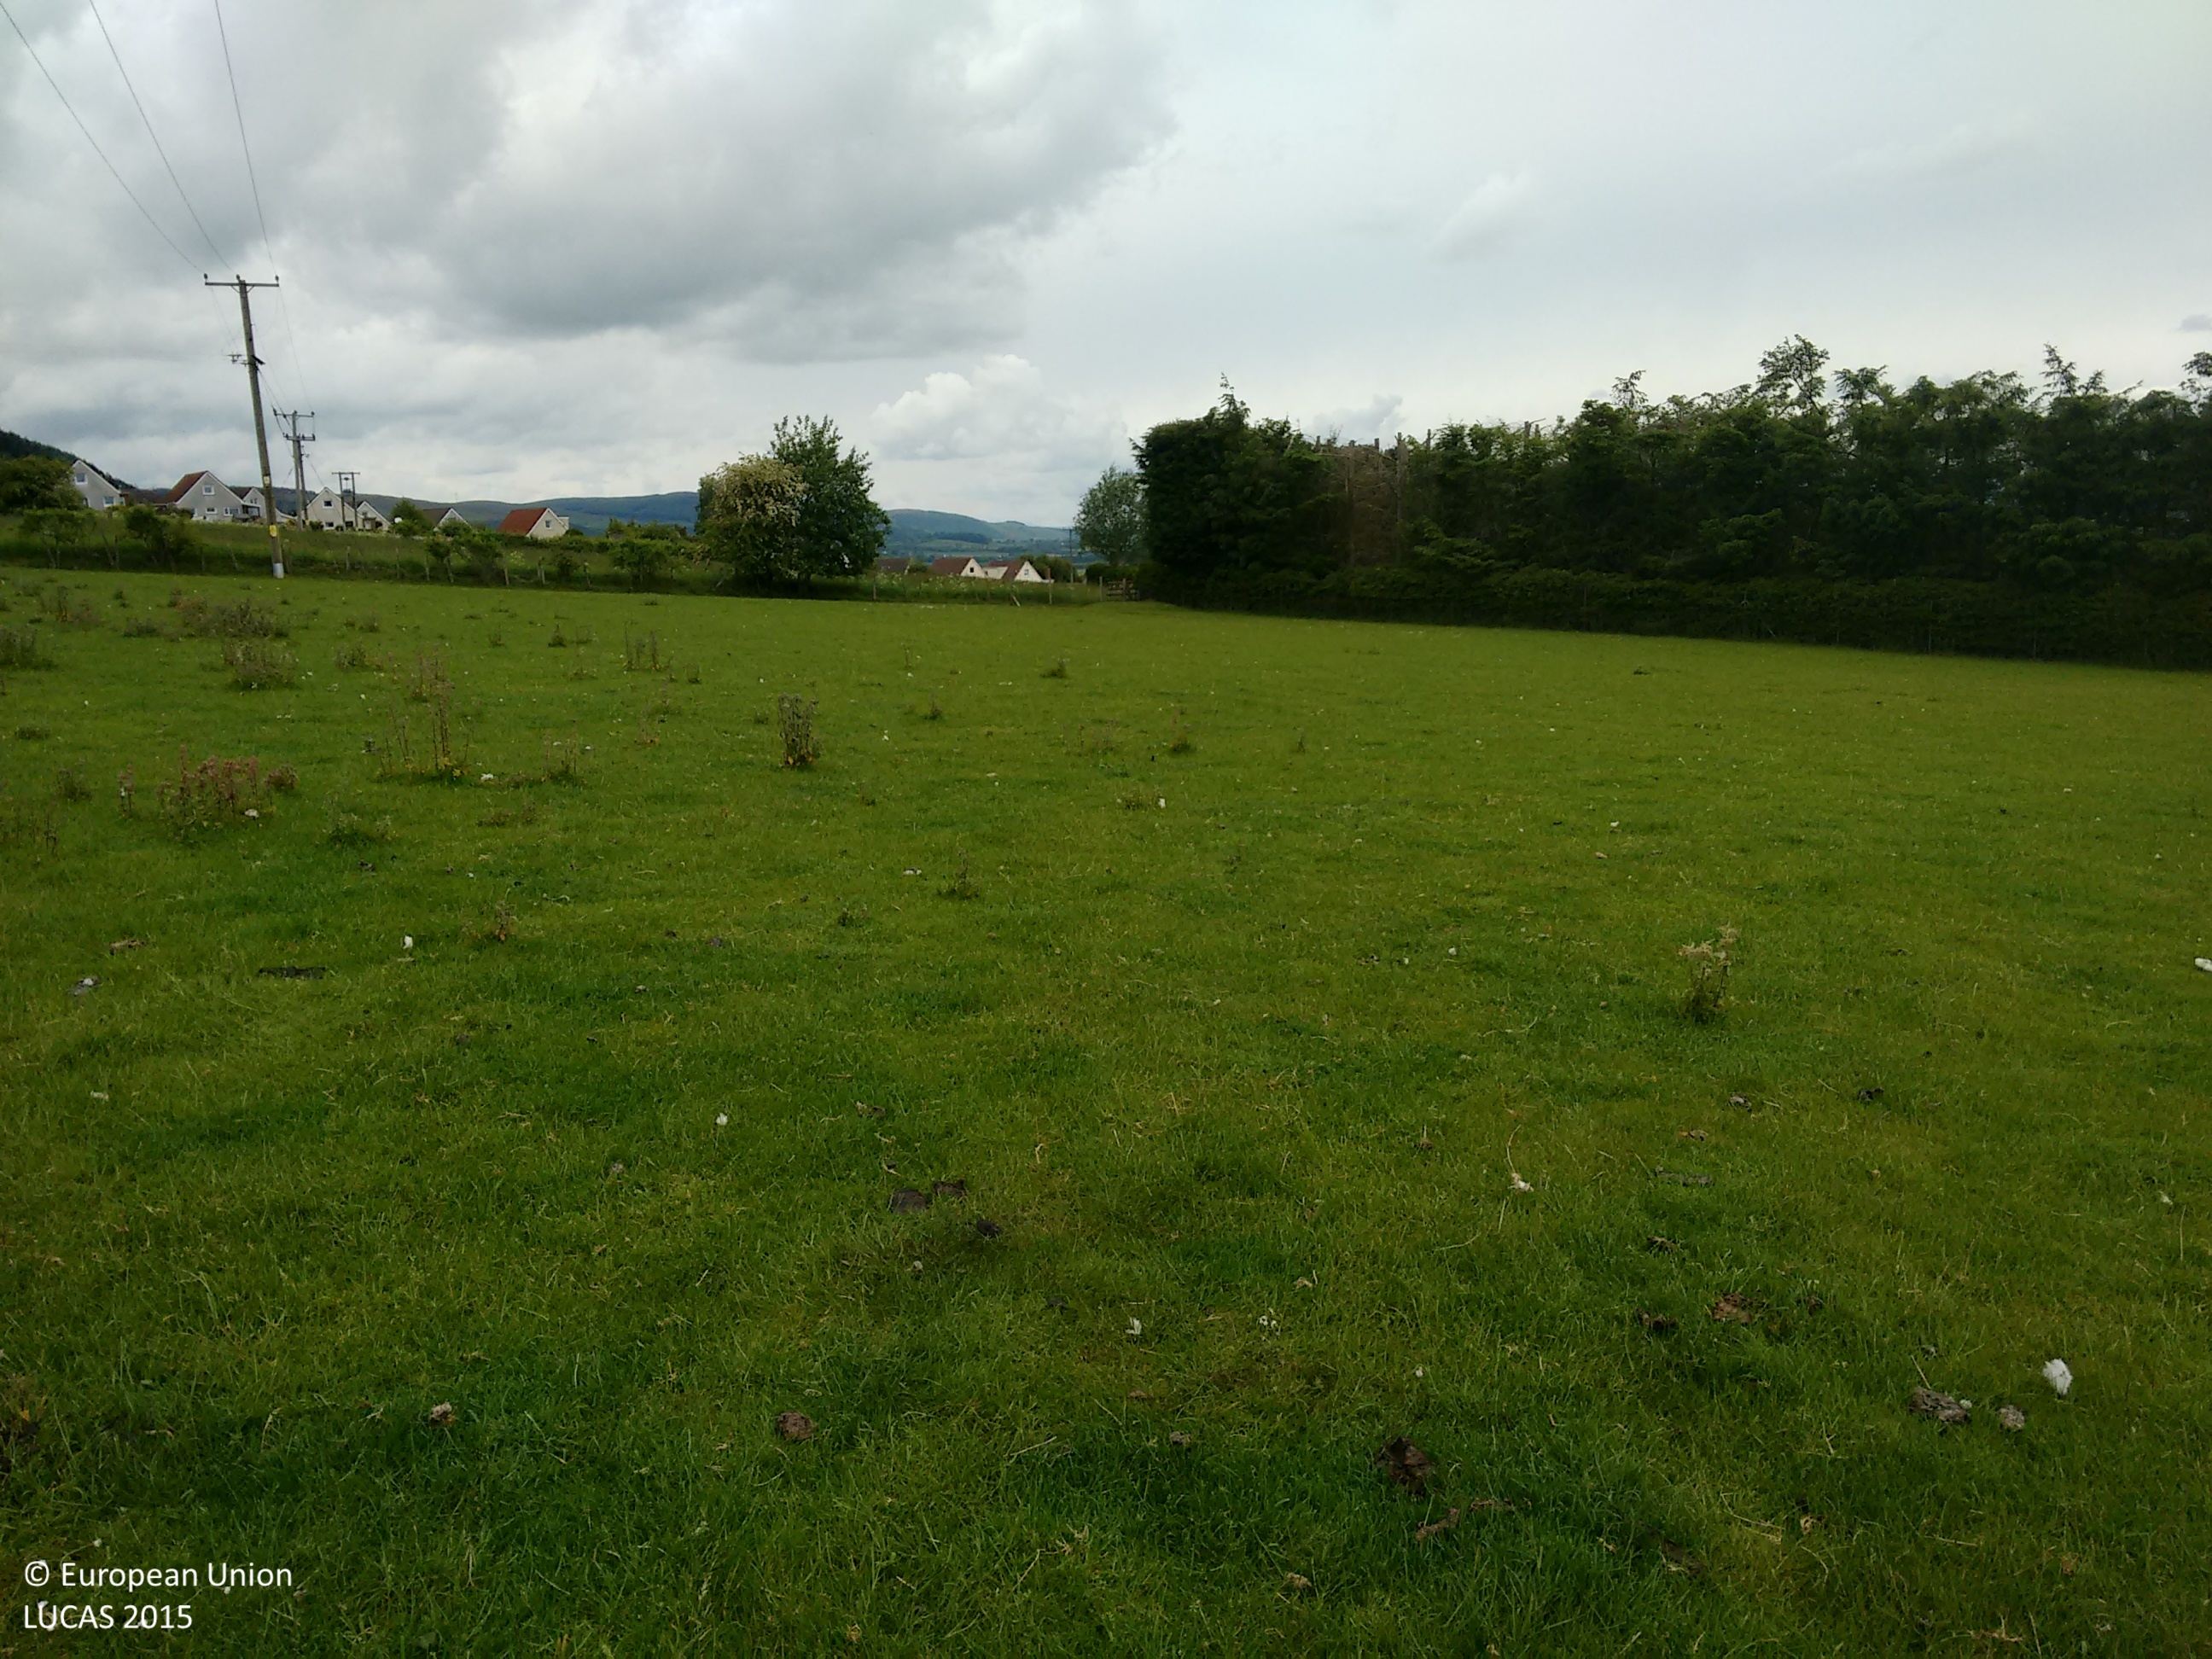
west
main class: Grassland
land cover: Grassland without tree/shrub cover
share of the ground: > 75 %
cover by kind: herbaceous plants 100 %
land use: Agriculture (excluding fallow land and kitchen gardens)
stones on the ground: < 10 %
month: June
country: GB
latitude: 56.3291
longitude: -3.3177
